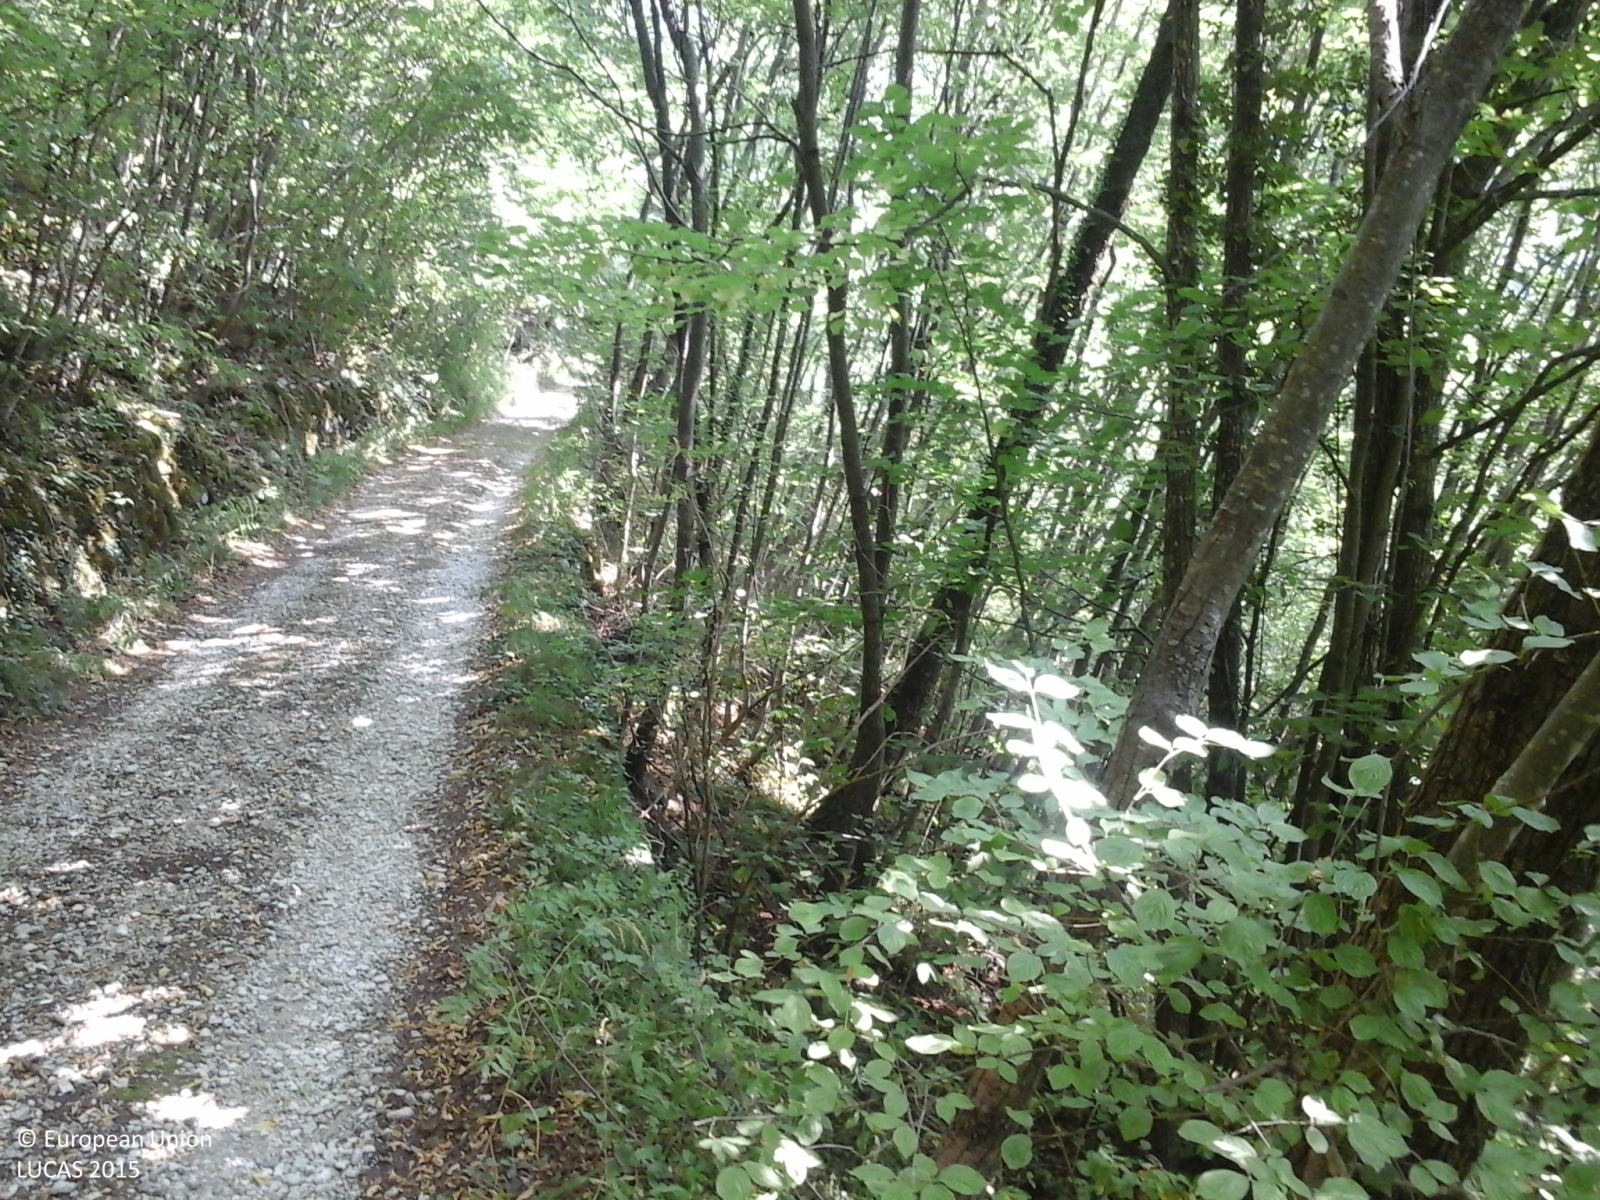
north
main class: Woodland
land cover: Broadleaved woodland
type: mountainous beech forest
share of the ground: > 75 %
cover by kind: broadleaved forest trees 100 %
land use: Forestry
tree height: > 5 m
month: July
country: IT
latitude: 45.6252
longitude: 11.0628
